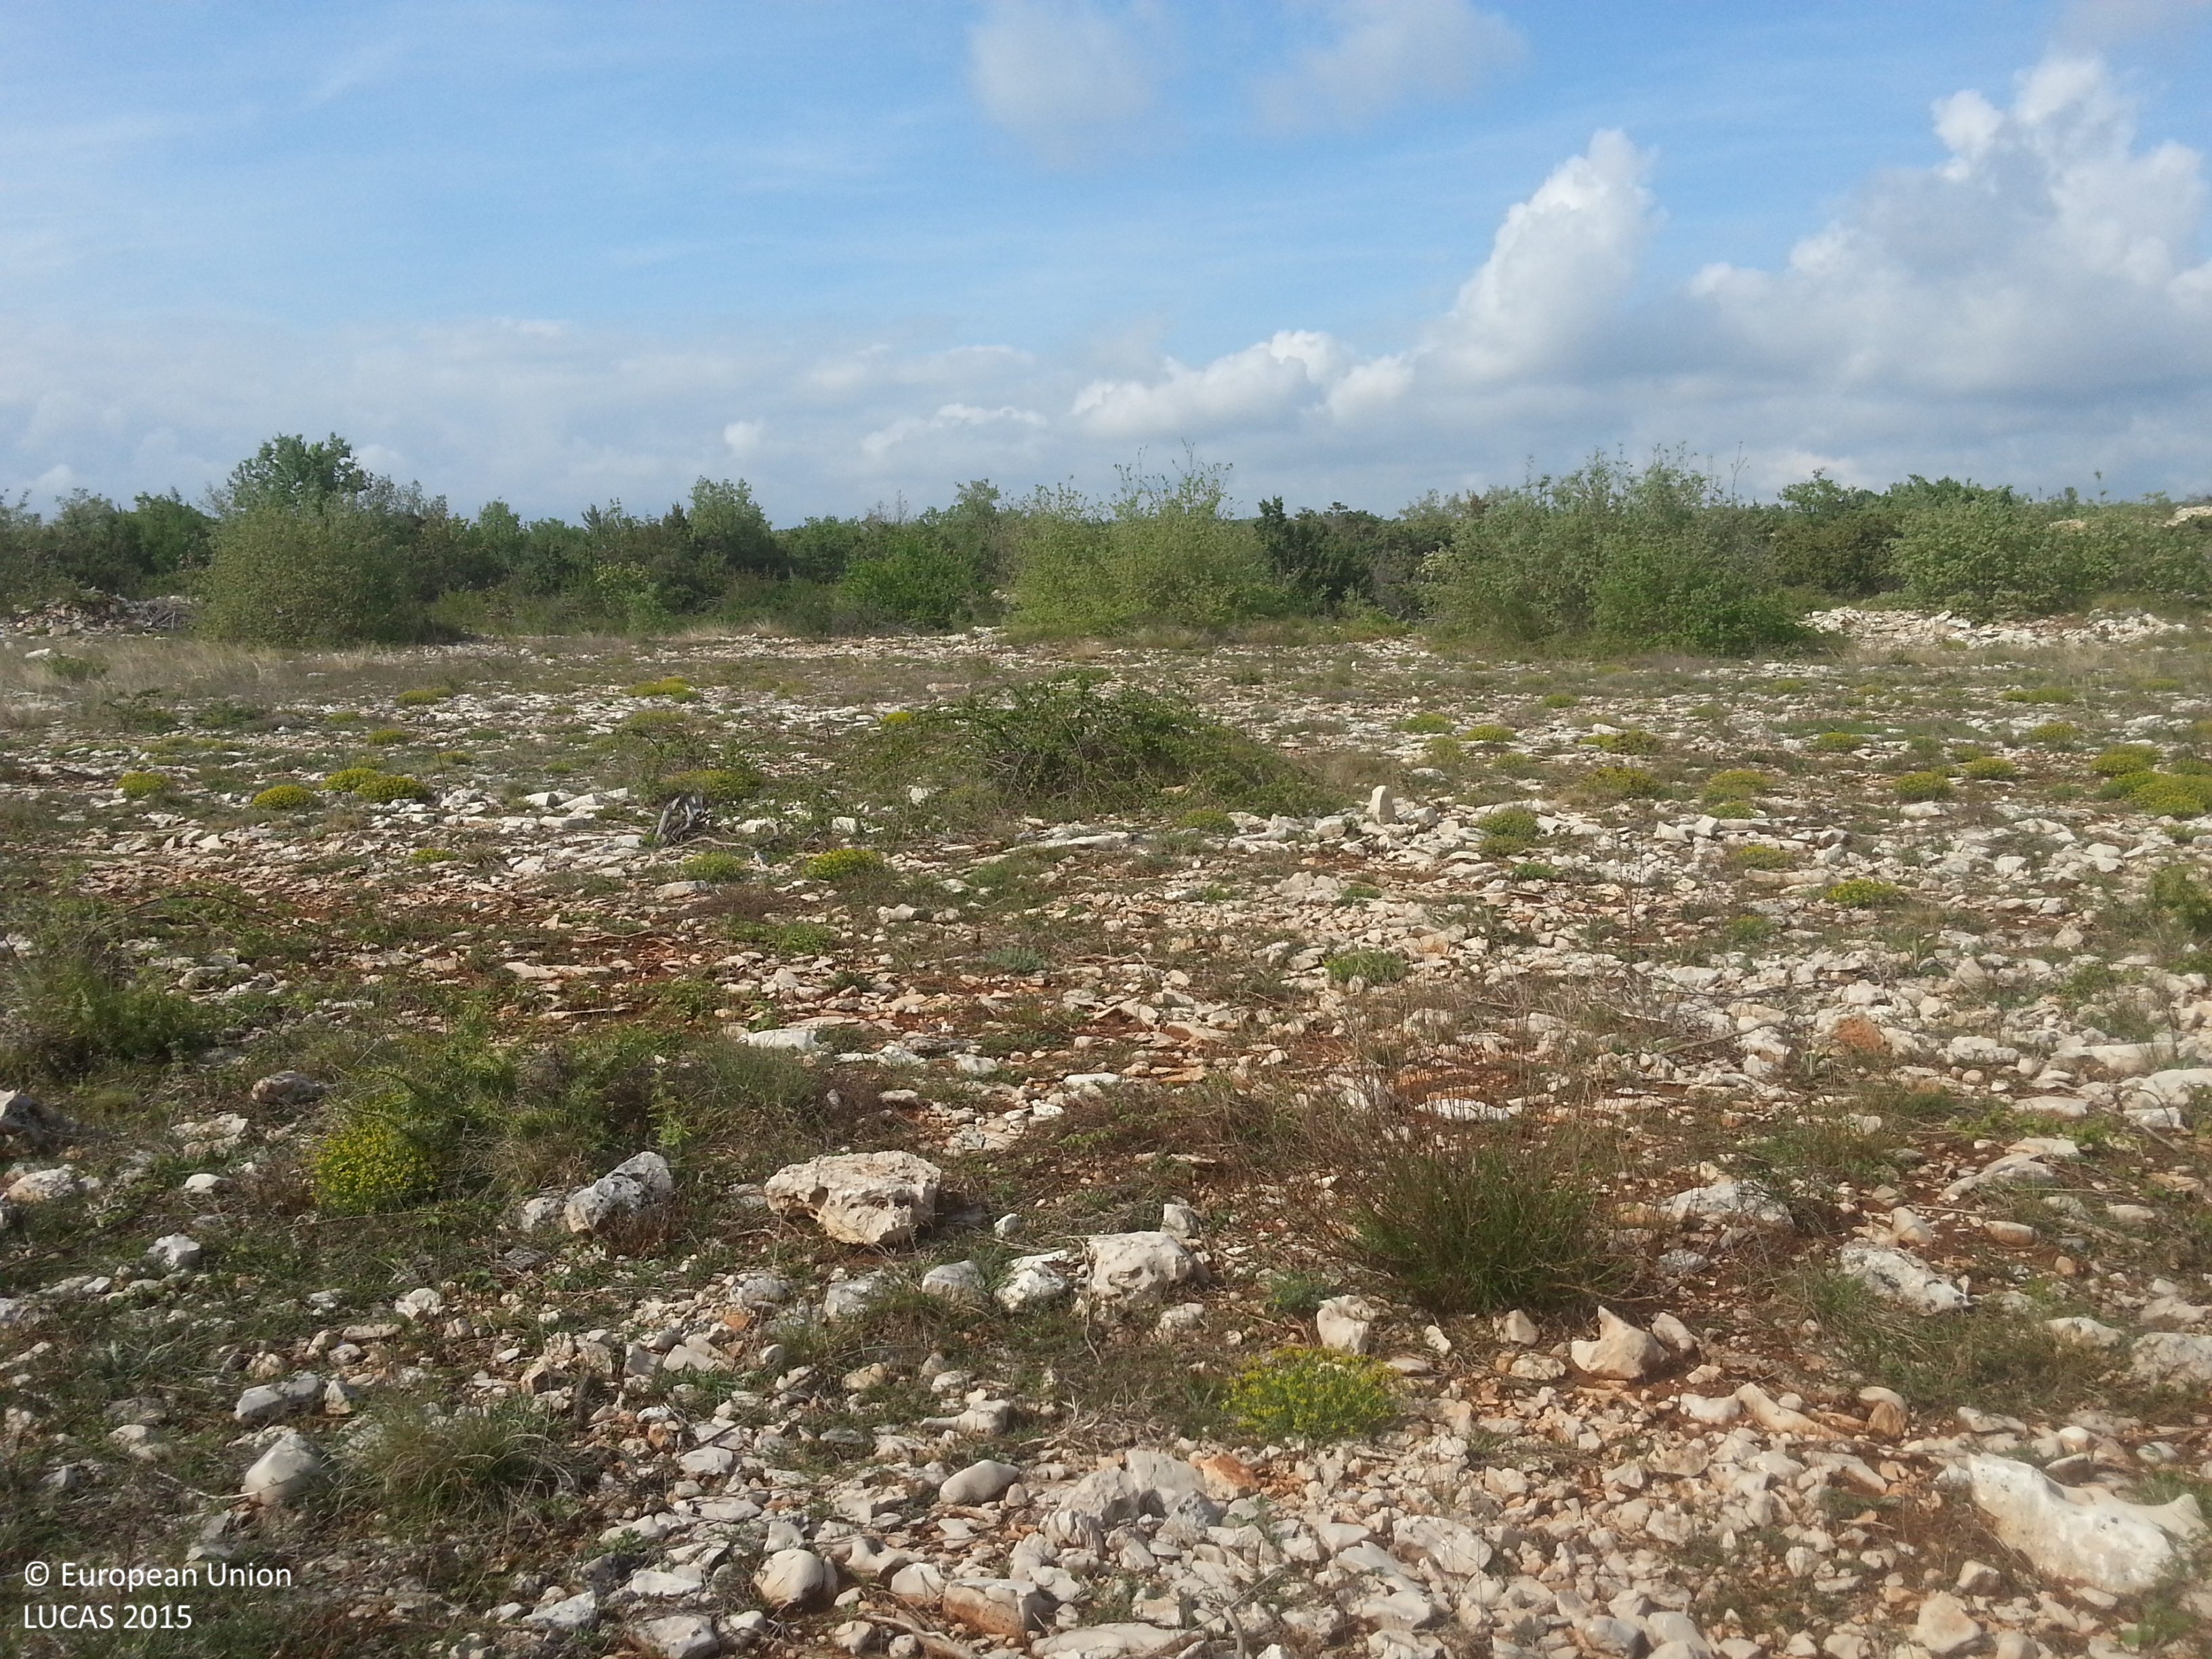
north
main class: Shrubland
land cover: Shrubland without tree cover
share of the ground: 10 - 25 %
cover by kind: unconsolidated bare surface 60 %, shrubs 20 %, herbaceous plants 15 %, consolidated bare surface 5 %
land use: Semi-natural and natural areas not in use
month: April
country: HR
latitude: 44.0522
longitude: 15.6462
